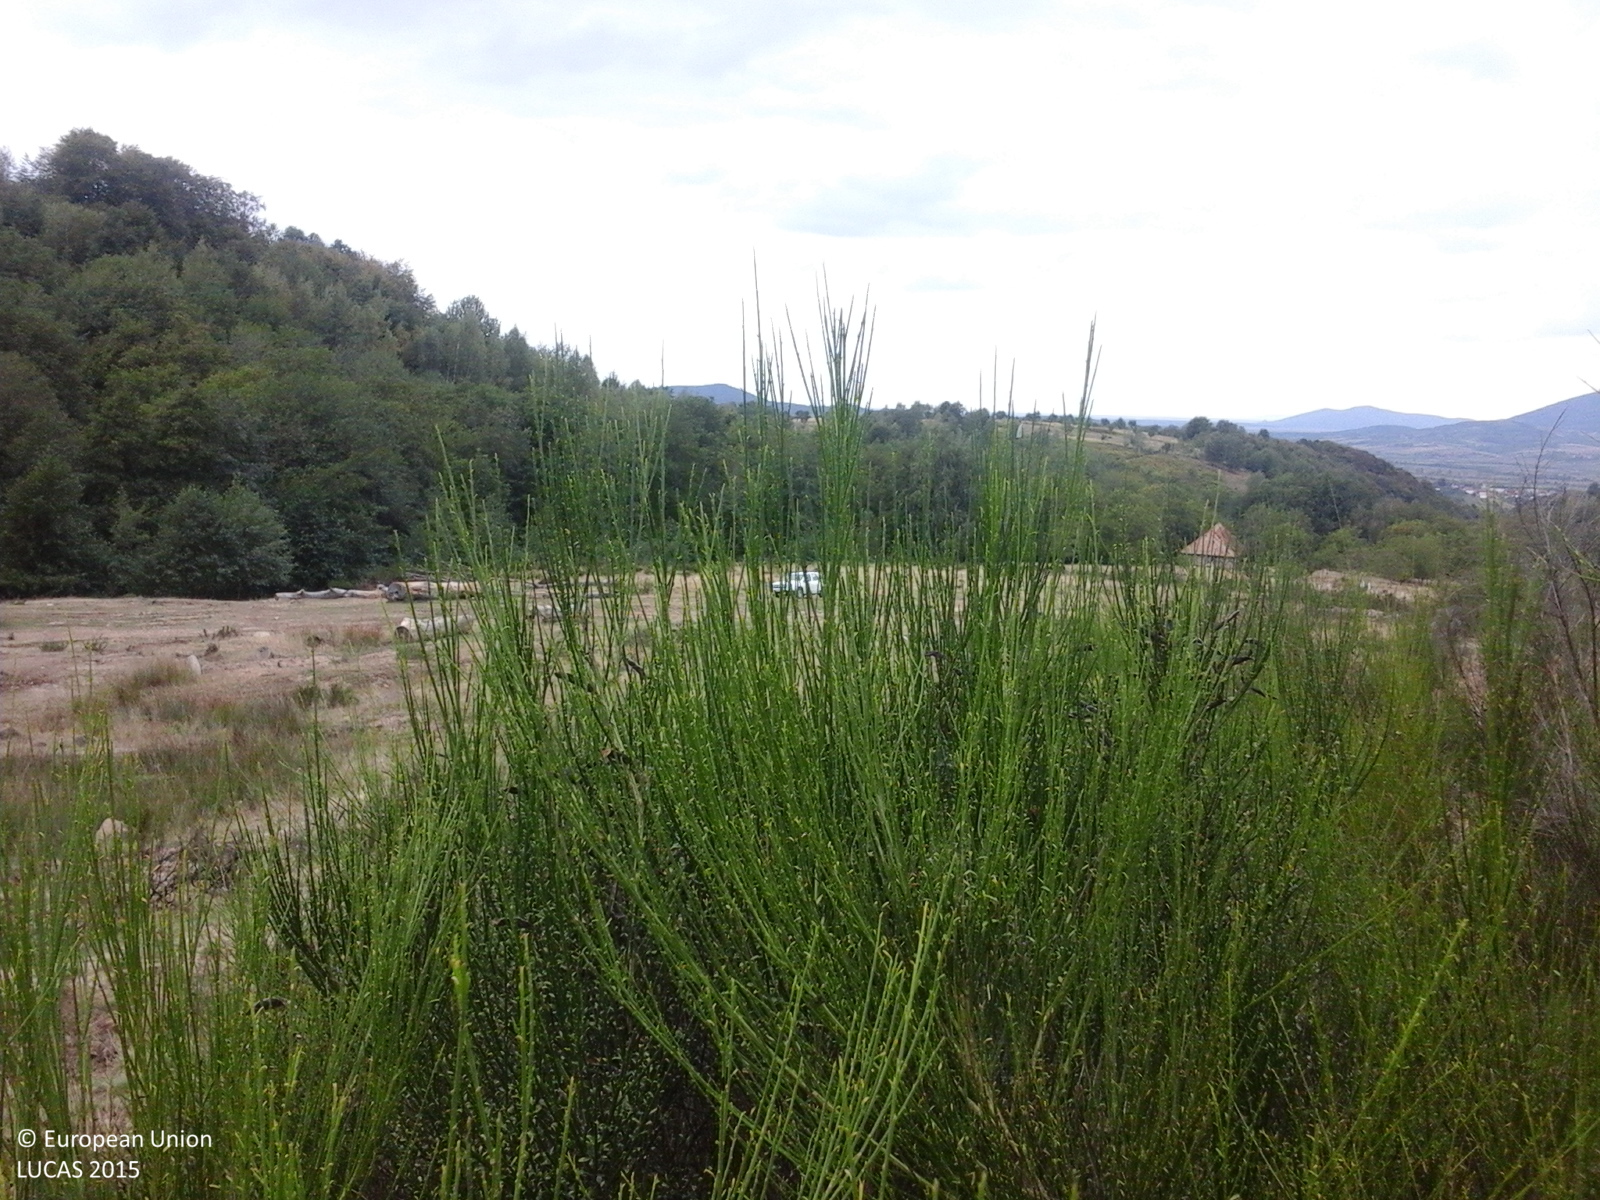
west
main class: Shrubland
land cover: Shrubland with sparse tree cover
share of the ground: > 75 %
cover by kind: herbaceous plants 70 %, shrubs 25 %, broadleaved forest trees 5 %
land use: Semi-natural and natural areas not in use
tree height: < 5 m
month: September
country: RO
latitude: 47.8072
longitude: 23.3593
